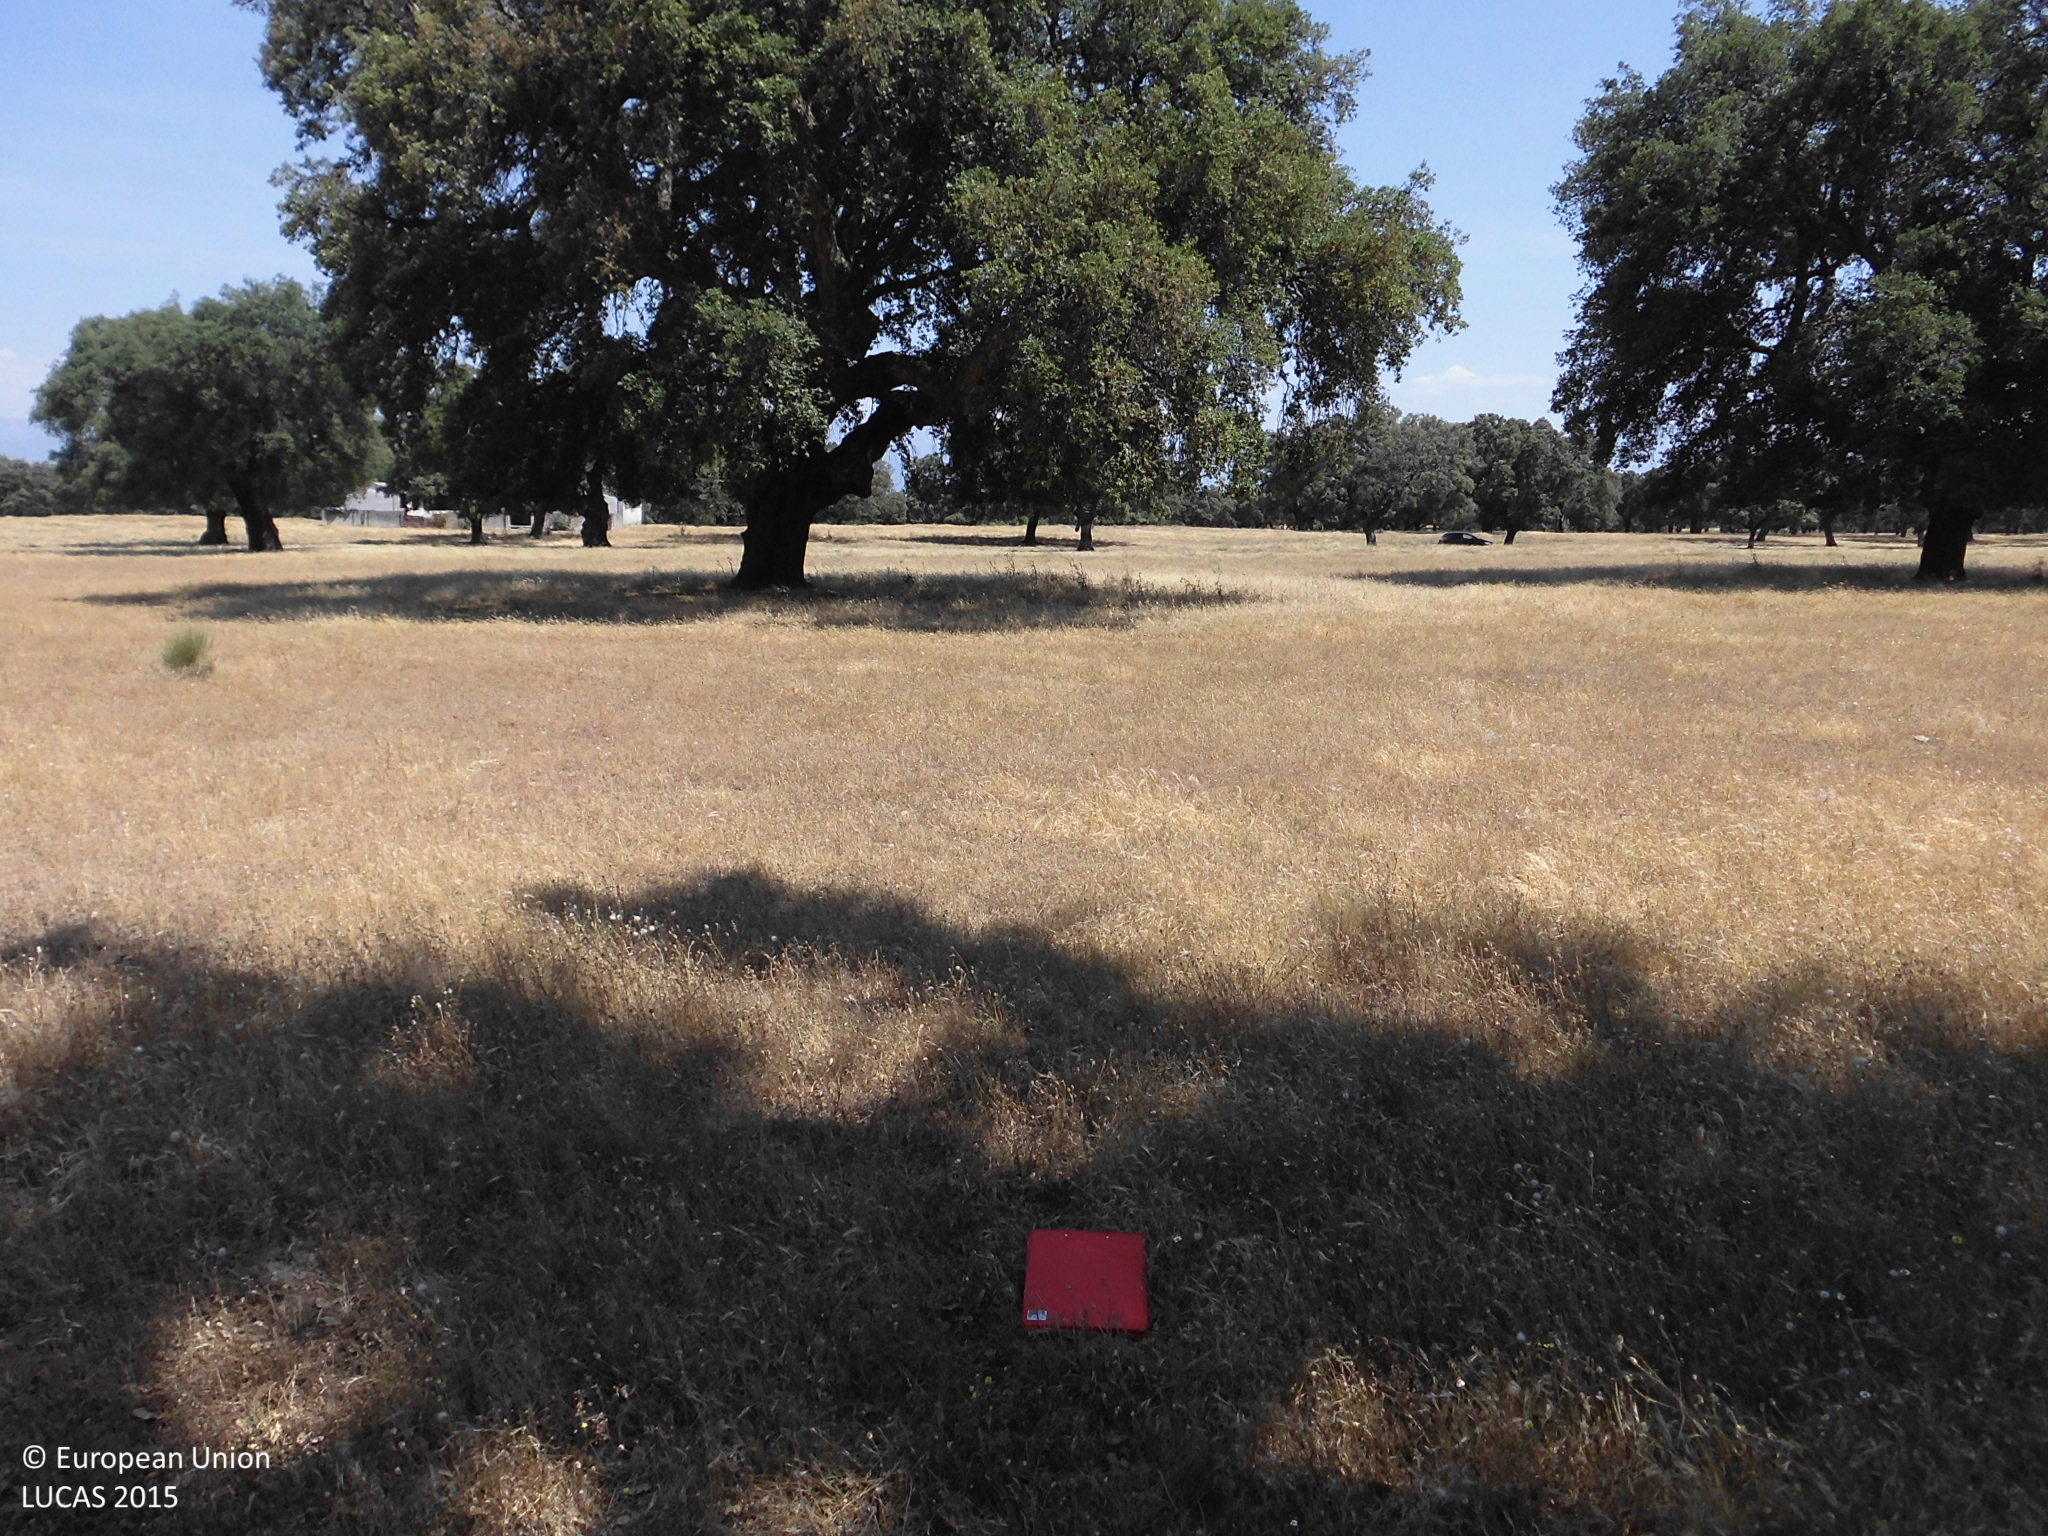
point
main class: Woodland
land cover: Broadleaved woodland
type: broadleaved evergreen forest
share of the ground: 25 - 50 %
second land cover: Grassland without tree/shrub cover
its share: > 75 %
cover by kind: herbaceous plants 75 %, broadleaved forest trees 25 %
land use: Forestry
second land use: Agriculture (excluding fallow land and kitchen gardens)
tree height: > 5 m
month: June
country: ES
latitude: 39.9364
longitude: -5.4465
